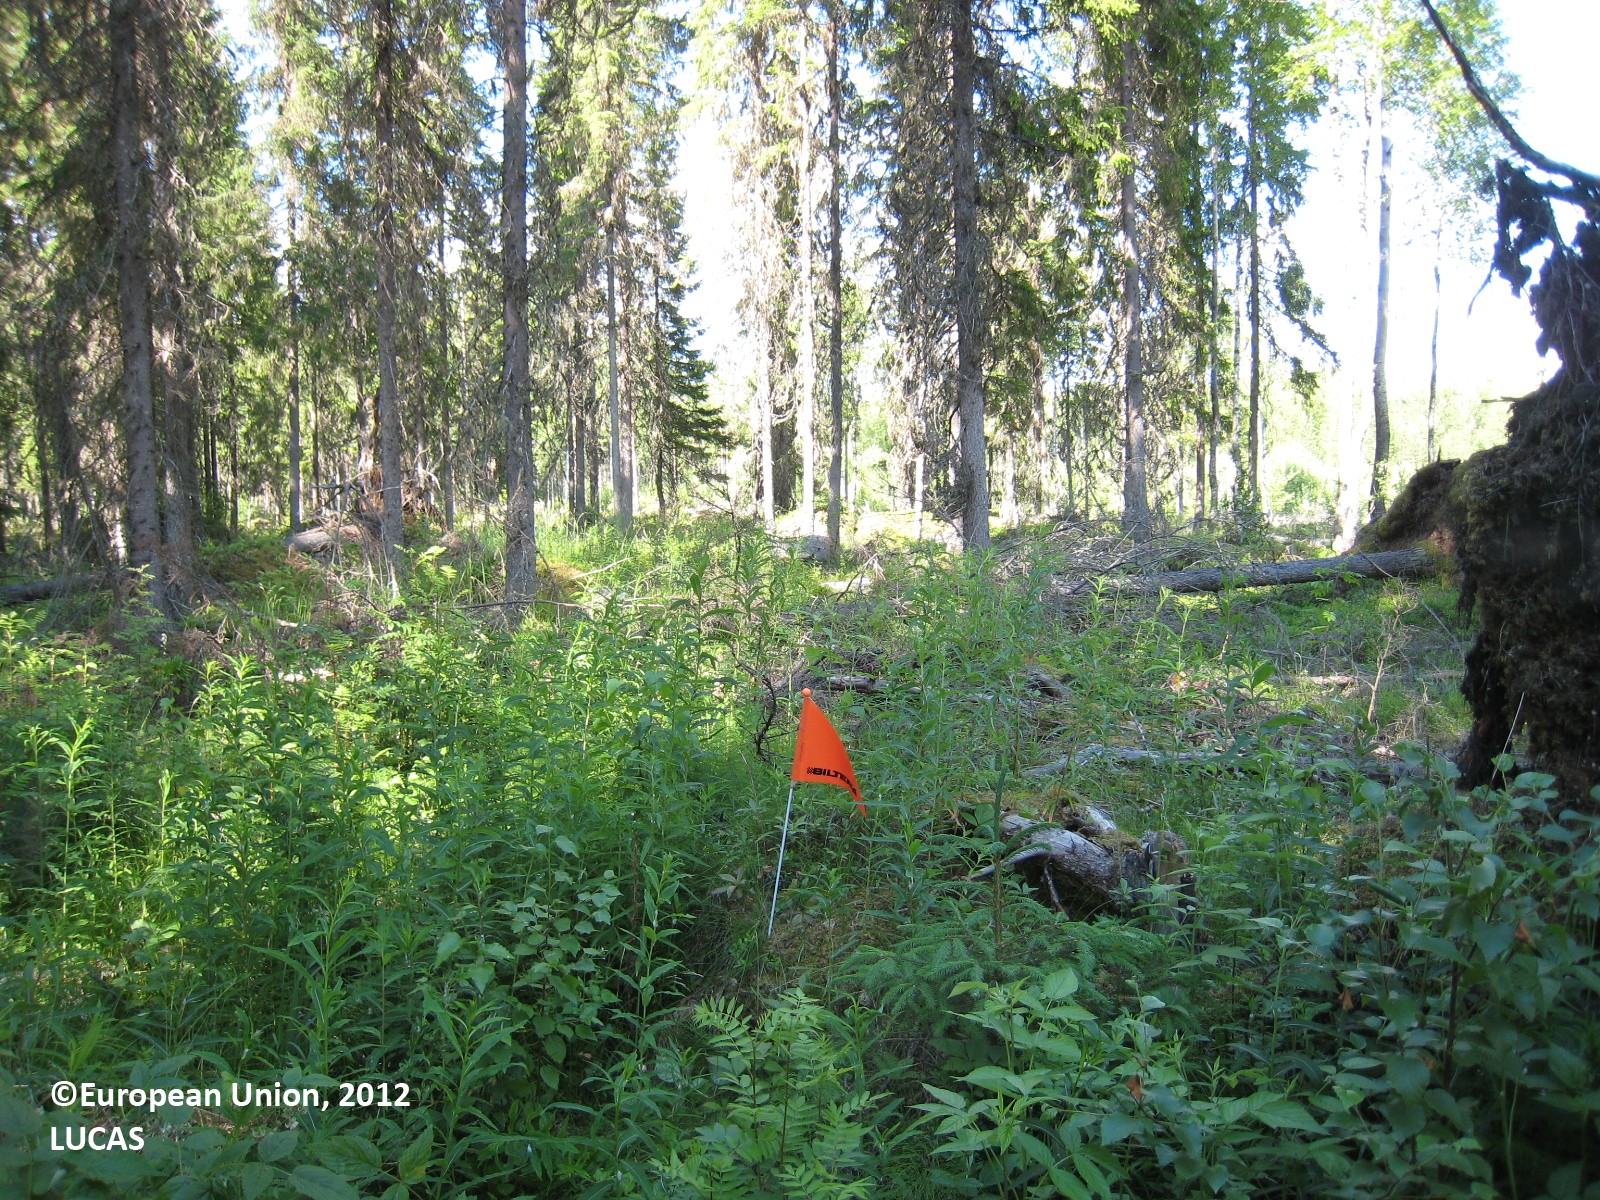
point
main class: Woodland
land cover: Spruce dominated coniferous woodland
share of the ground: 25 - 50 %
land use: Forestry
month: July
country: FI
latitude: 62.6036
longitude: 26.1194
